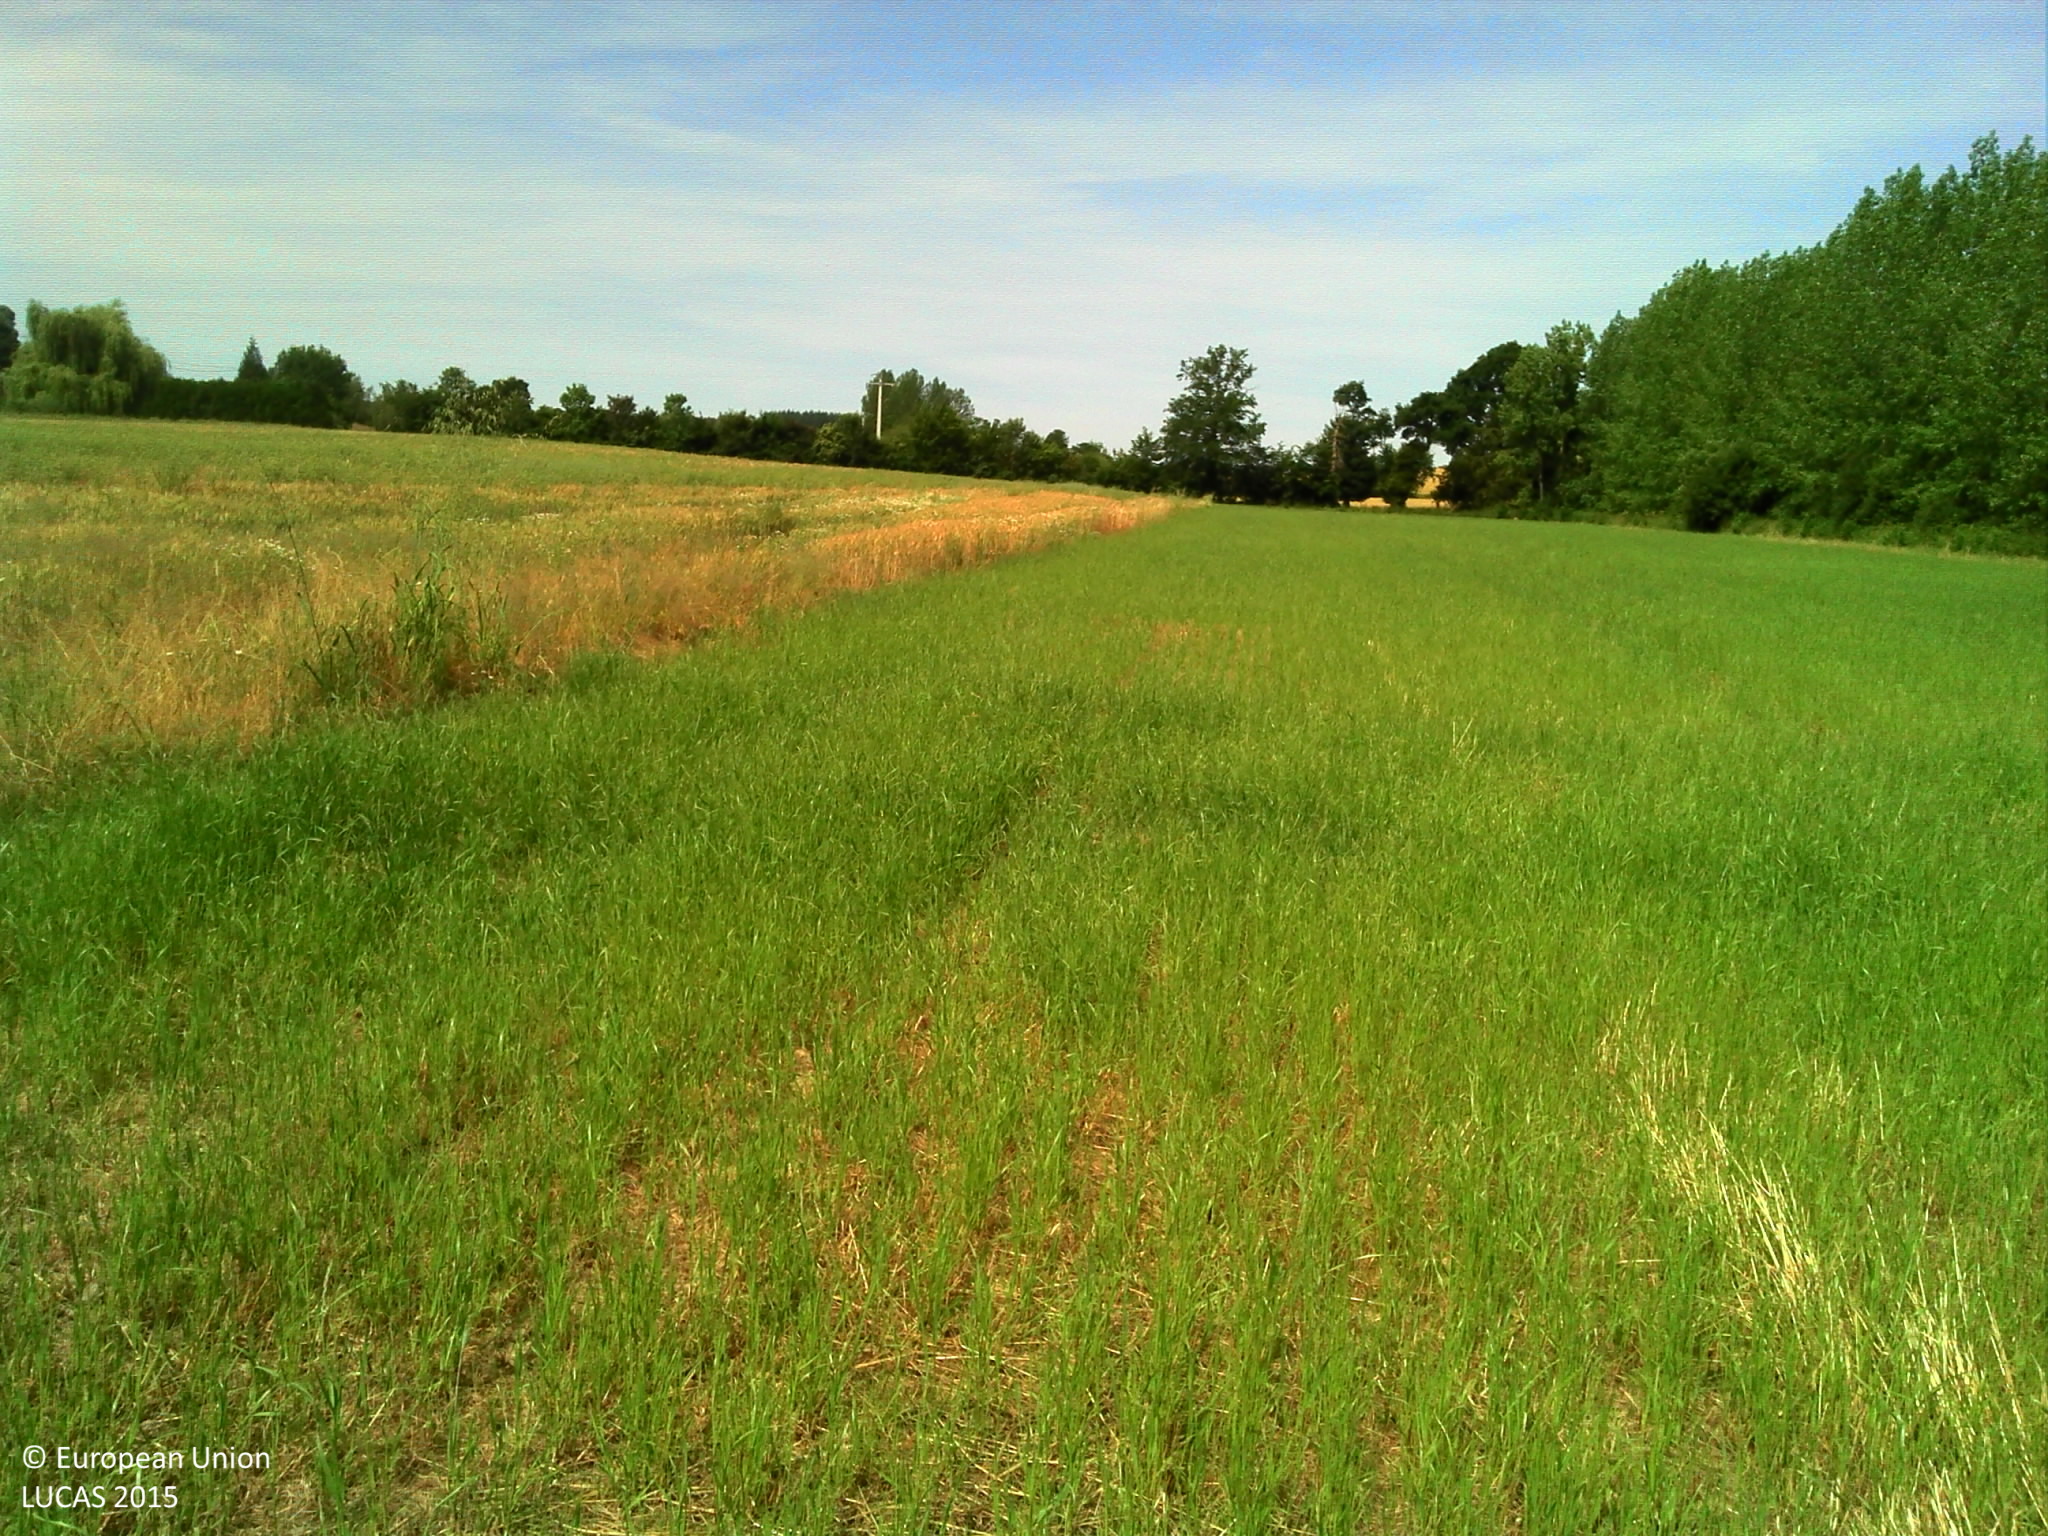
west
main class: Grassland
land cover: Grassland without tree/shrub cover
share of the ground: > 75 %
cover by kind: herbaceous plants 100 %
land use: Agriculture (excluding fallow land and kitchen gardens)
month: June
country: FR
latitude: 48.0792
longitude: -1.9581
